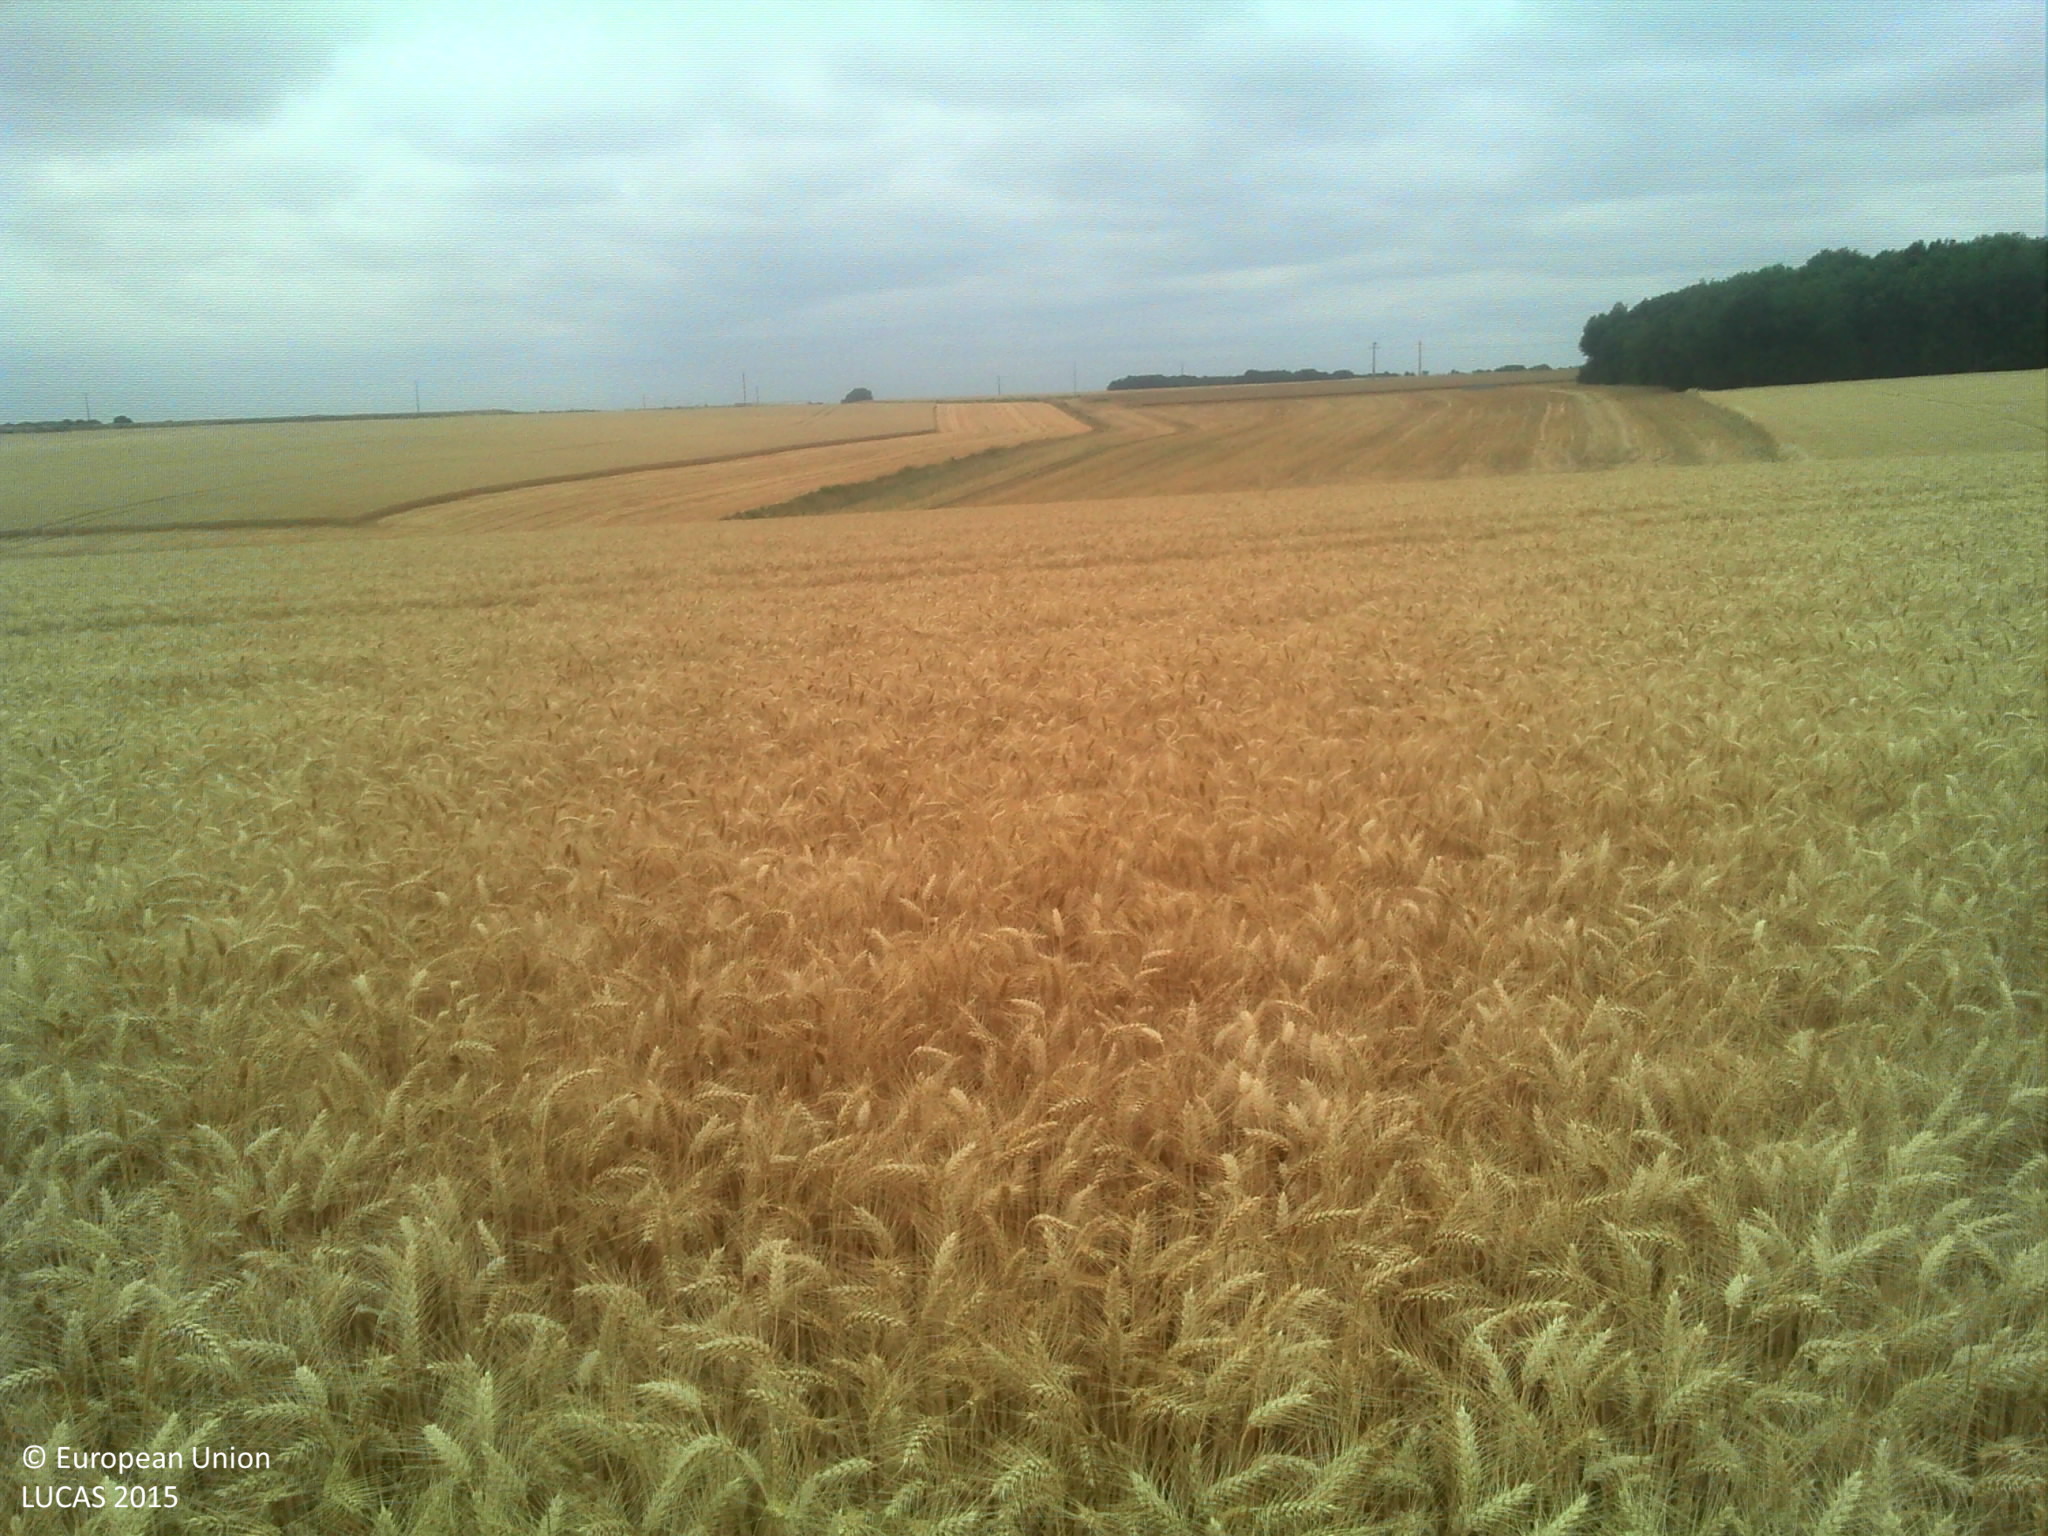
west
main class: Cropland
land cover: Common wheat
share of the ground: > 75 %
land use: Agriculture (excluding fallow land and kitchen gardens)
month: July
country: FR
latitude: 47.7244
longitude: 0.7407
